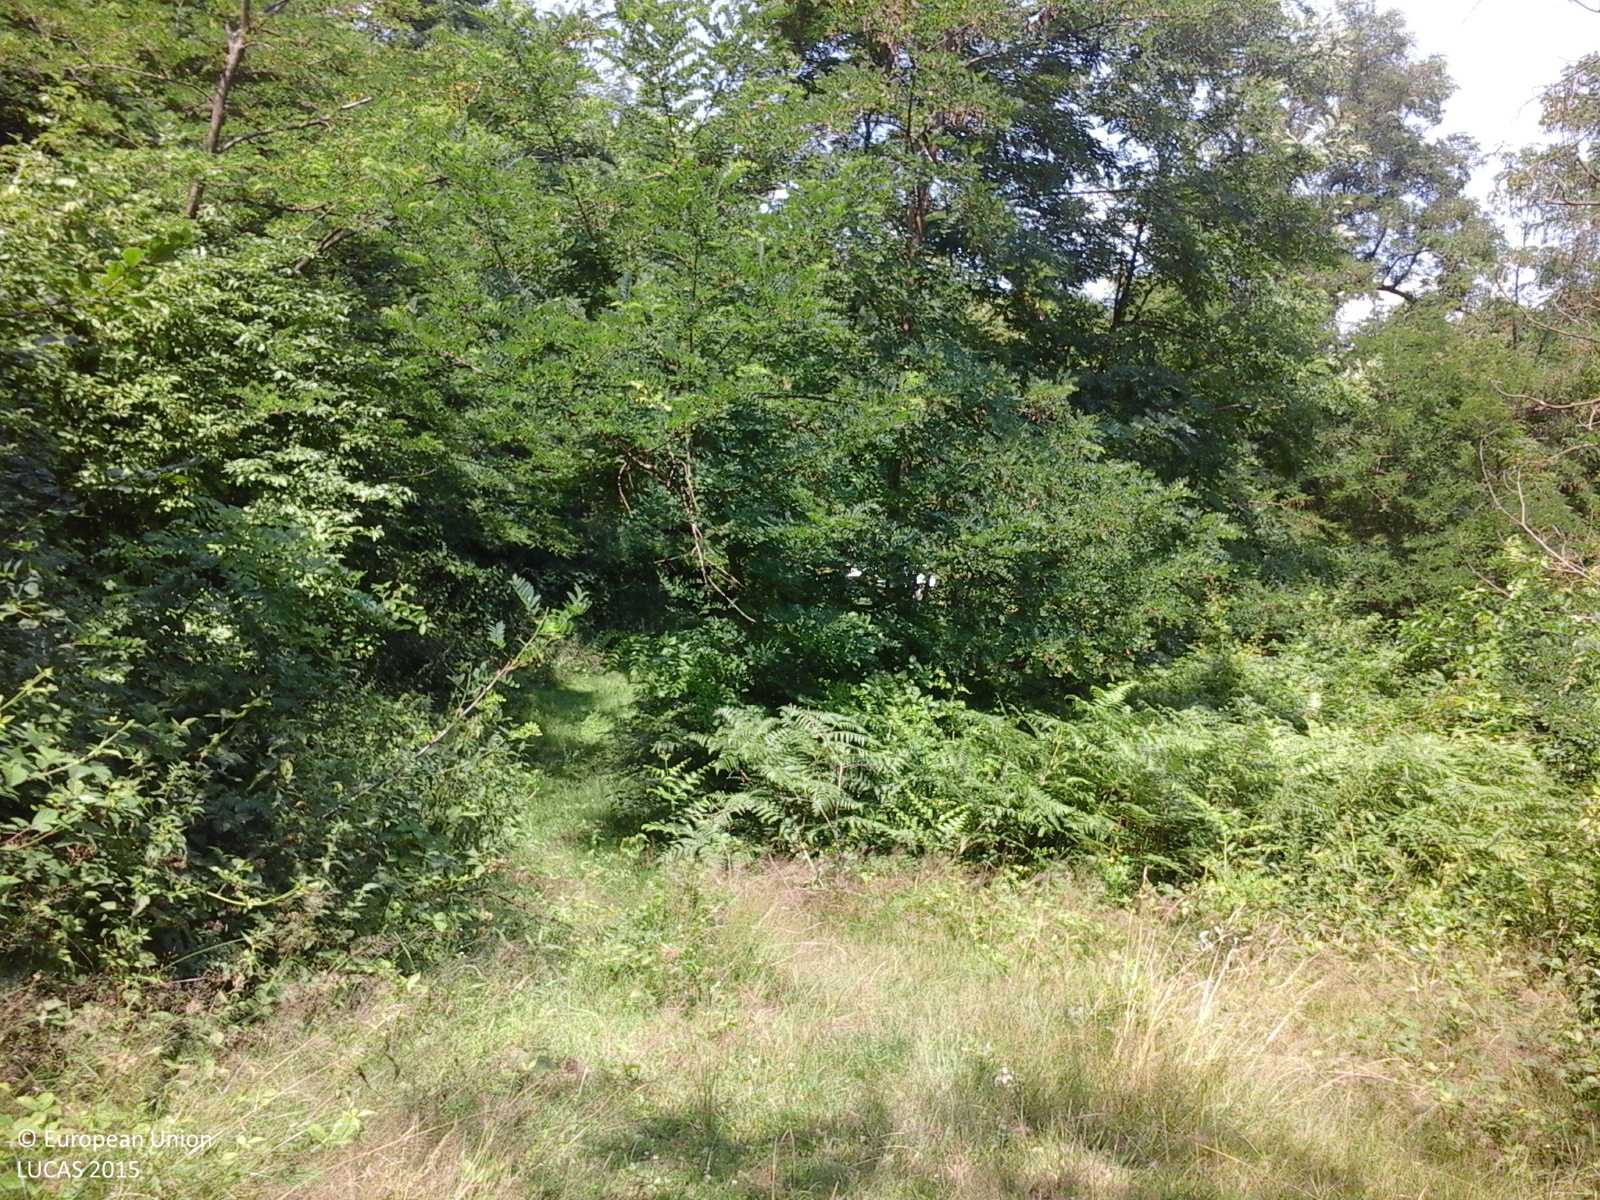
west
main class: Woodland
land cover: Broadleaved woodland
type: exotic forest
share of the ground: > 75 %
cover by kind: broadleaved forest trees 100 %
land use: Forestry
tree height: > 5 m
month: July
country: RO
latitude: 45.0408
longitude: 24.6654
